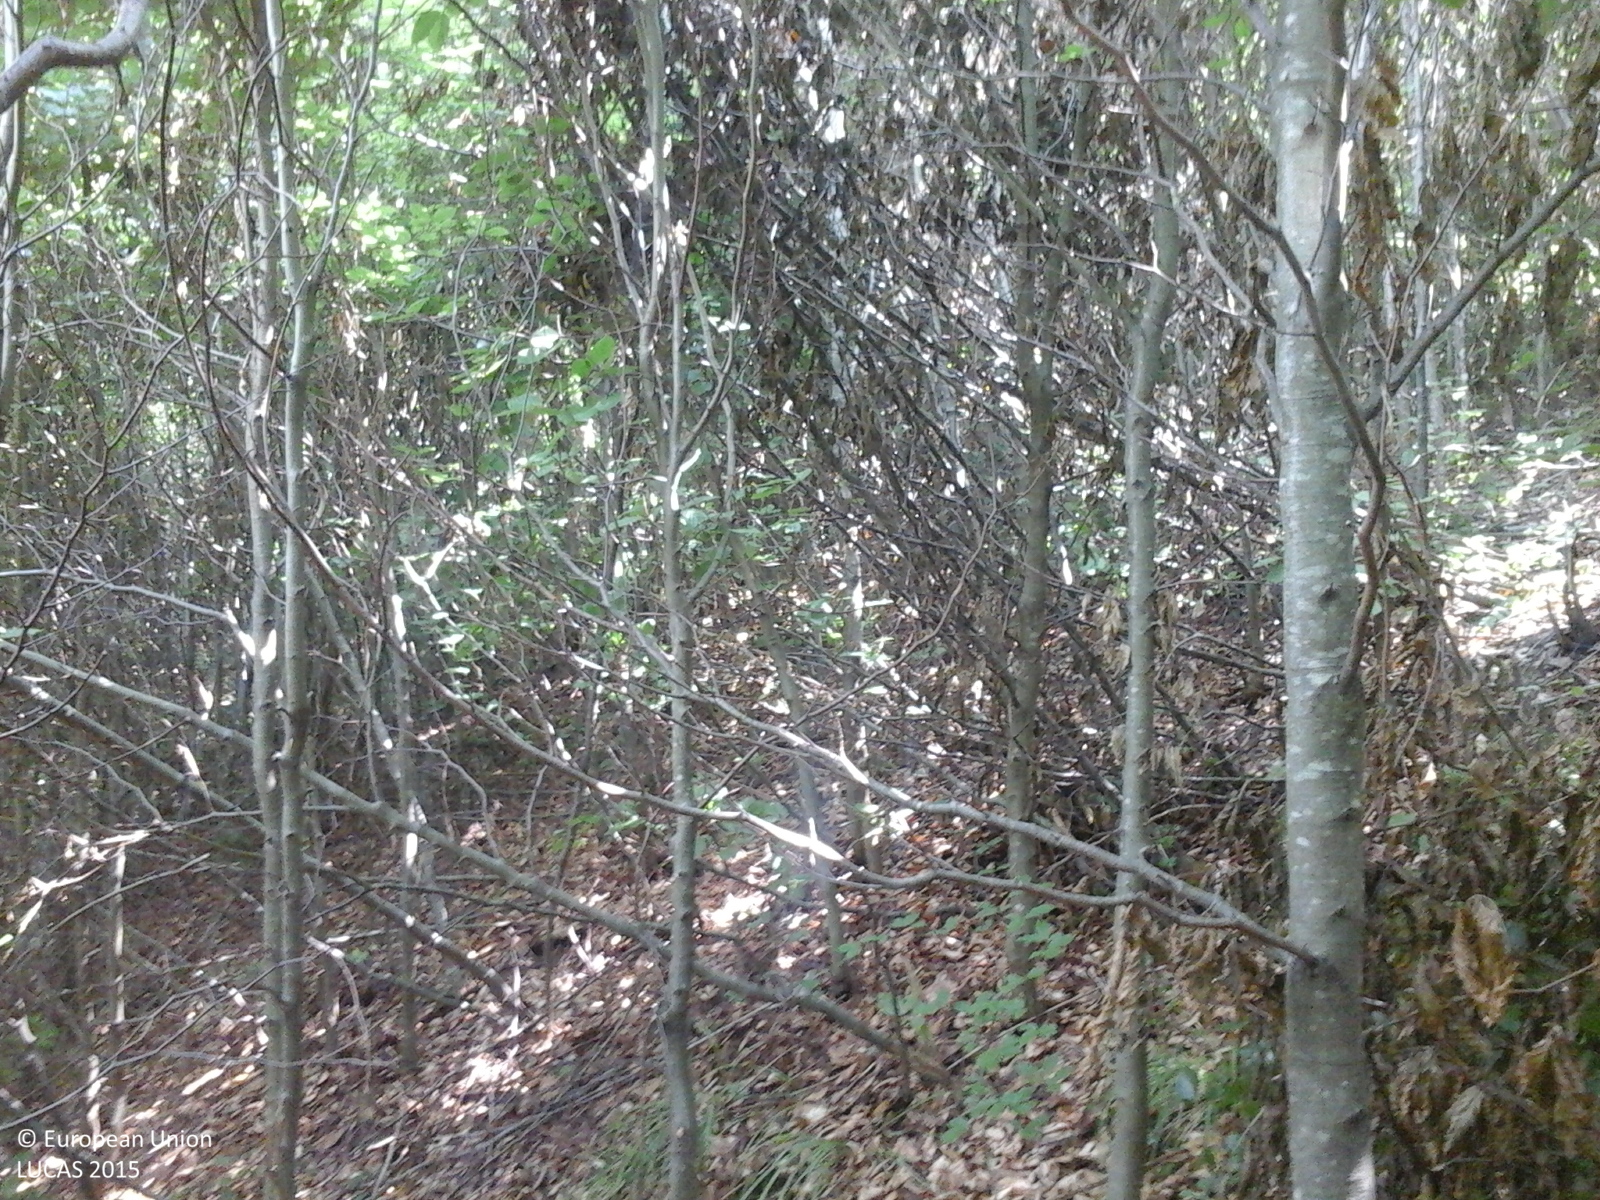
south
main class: Woodland
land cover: Other mixed woodland
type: beech forest
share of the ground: > 75 %
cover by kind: broadleaved forest trees 75 %, coniferous forest trees 25 %
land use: Forestry
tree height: > 5 m
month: July
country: RO
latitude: 45.3828
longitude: 24.5753
